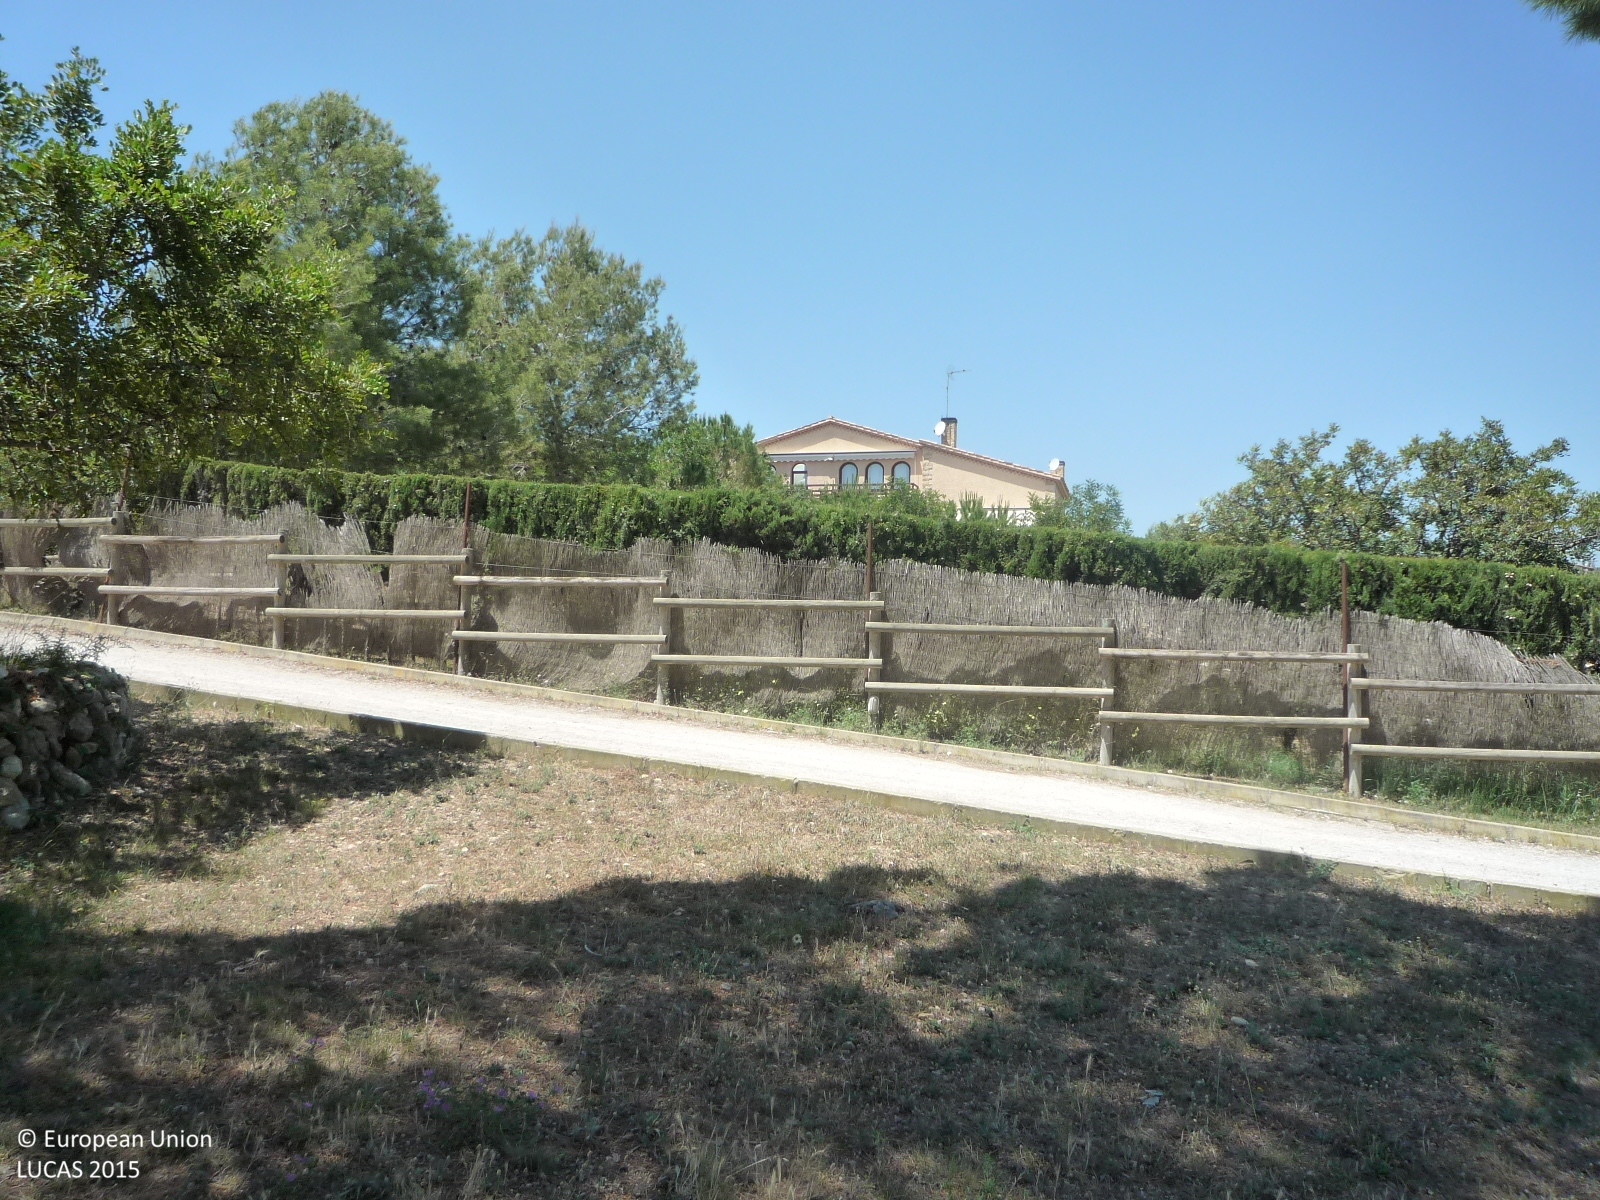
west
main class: Woodland
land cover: Pine dominated coniferous woodland
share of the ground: 25 - 50 %
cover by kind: herbaceous plants 70 %, coniferous forest trees 30 %
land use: Sport
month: May
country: ES
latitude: 41.2419
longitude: 1.7013
